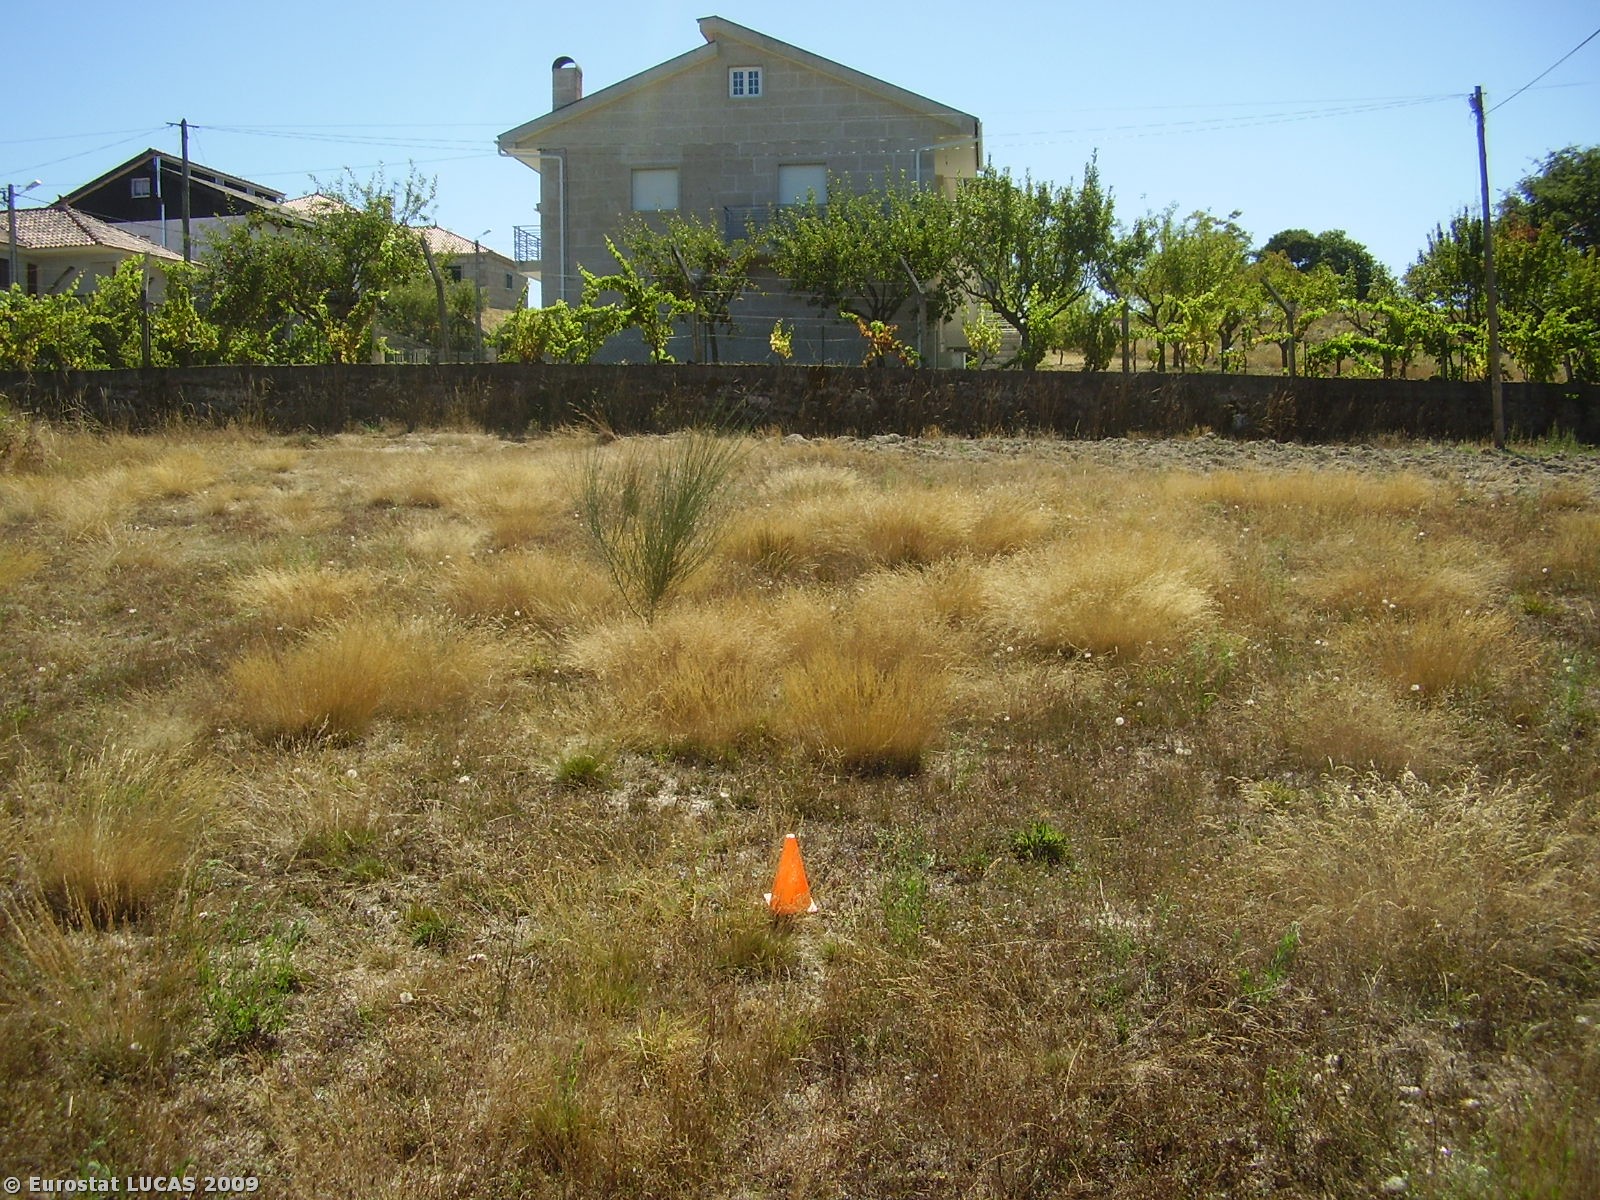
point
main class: Grassland
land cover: Spontaneously vegetated surfaces
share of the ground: > 75 %
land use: Fallow land
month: September
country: PT
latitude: 41.8481
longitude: -7.6364
